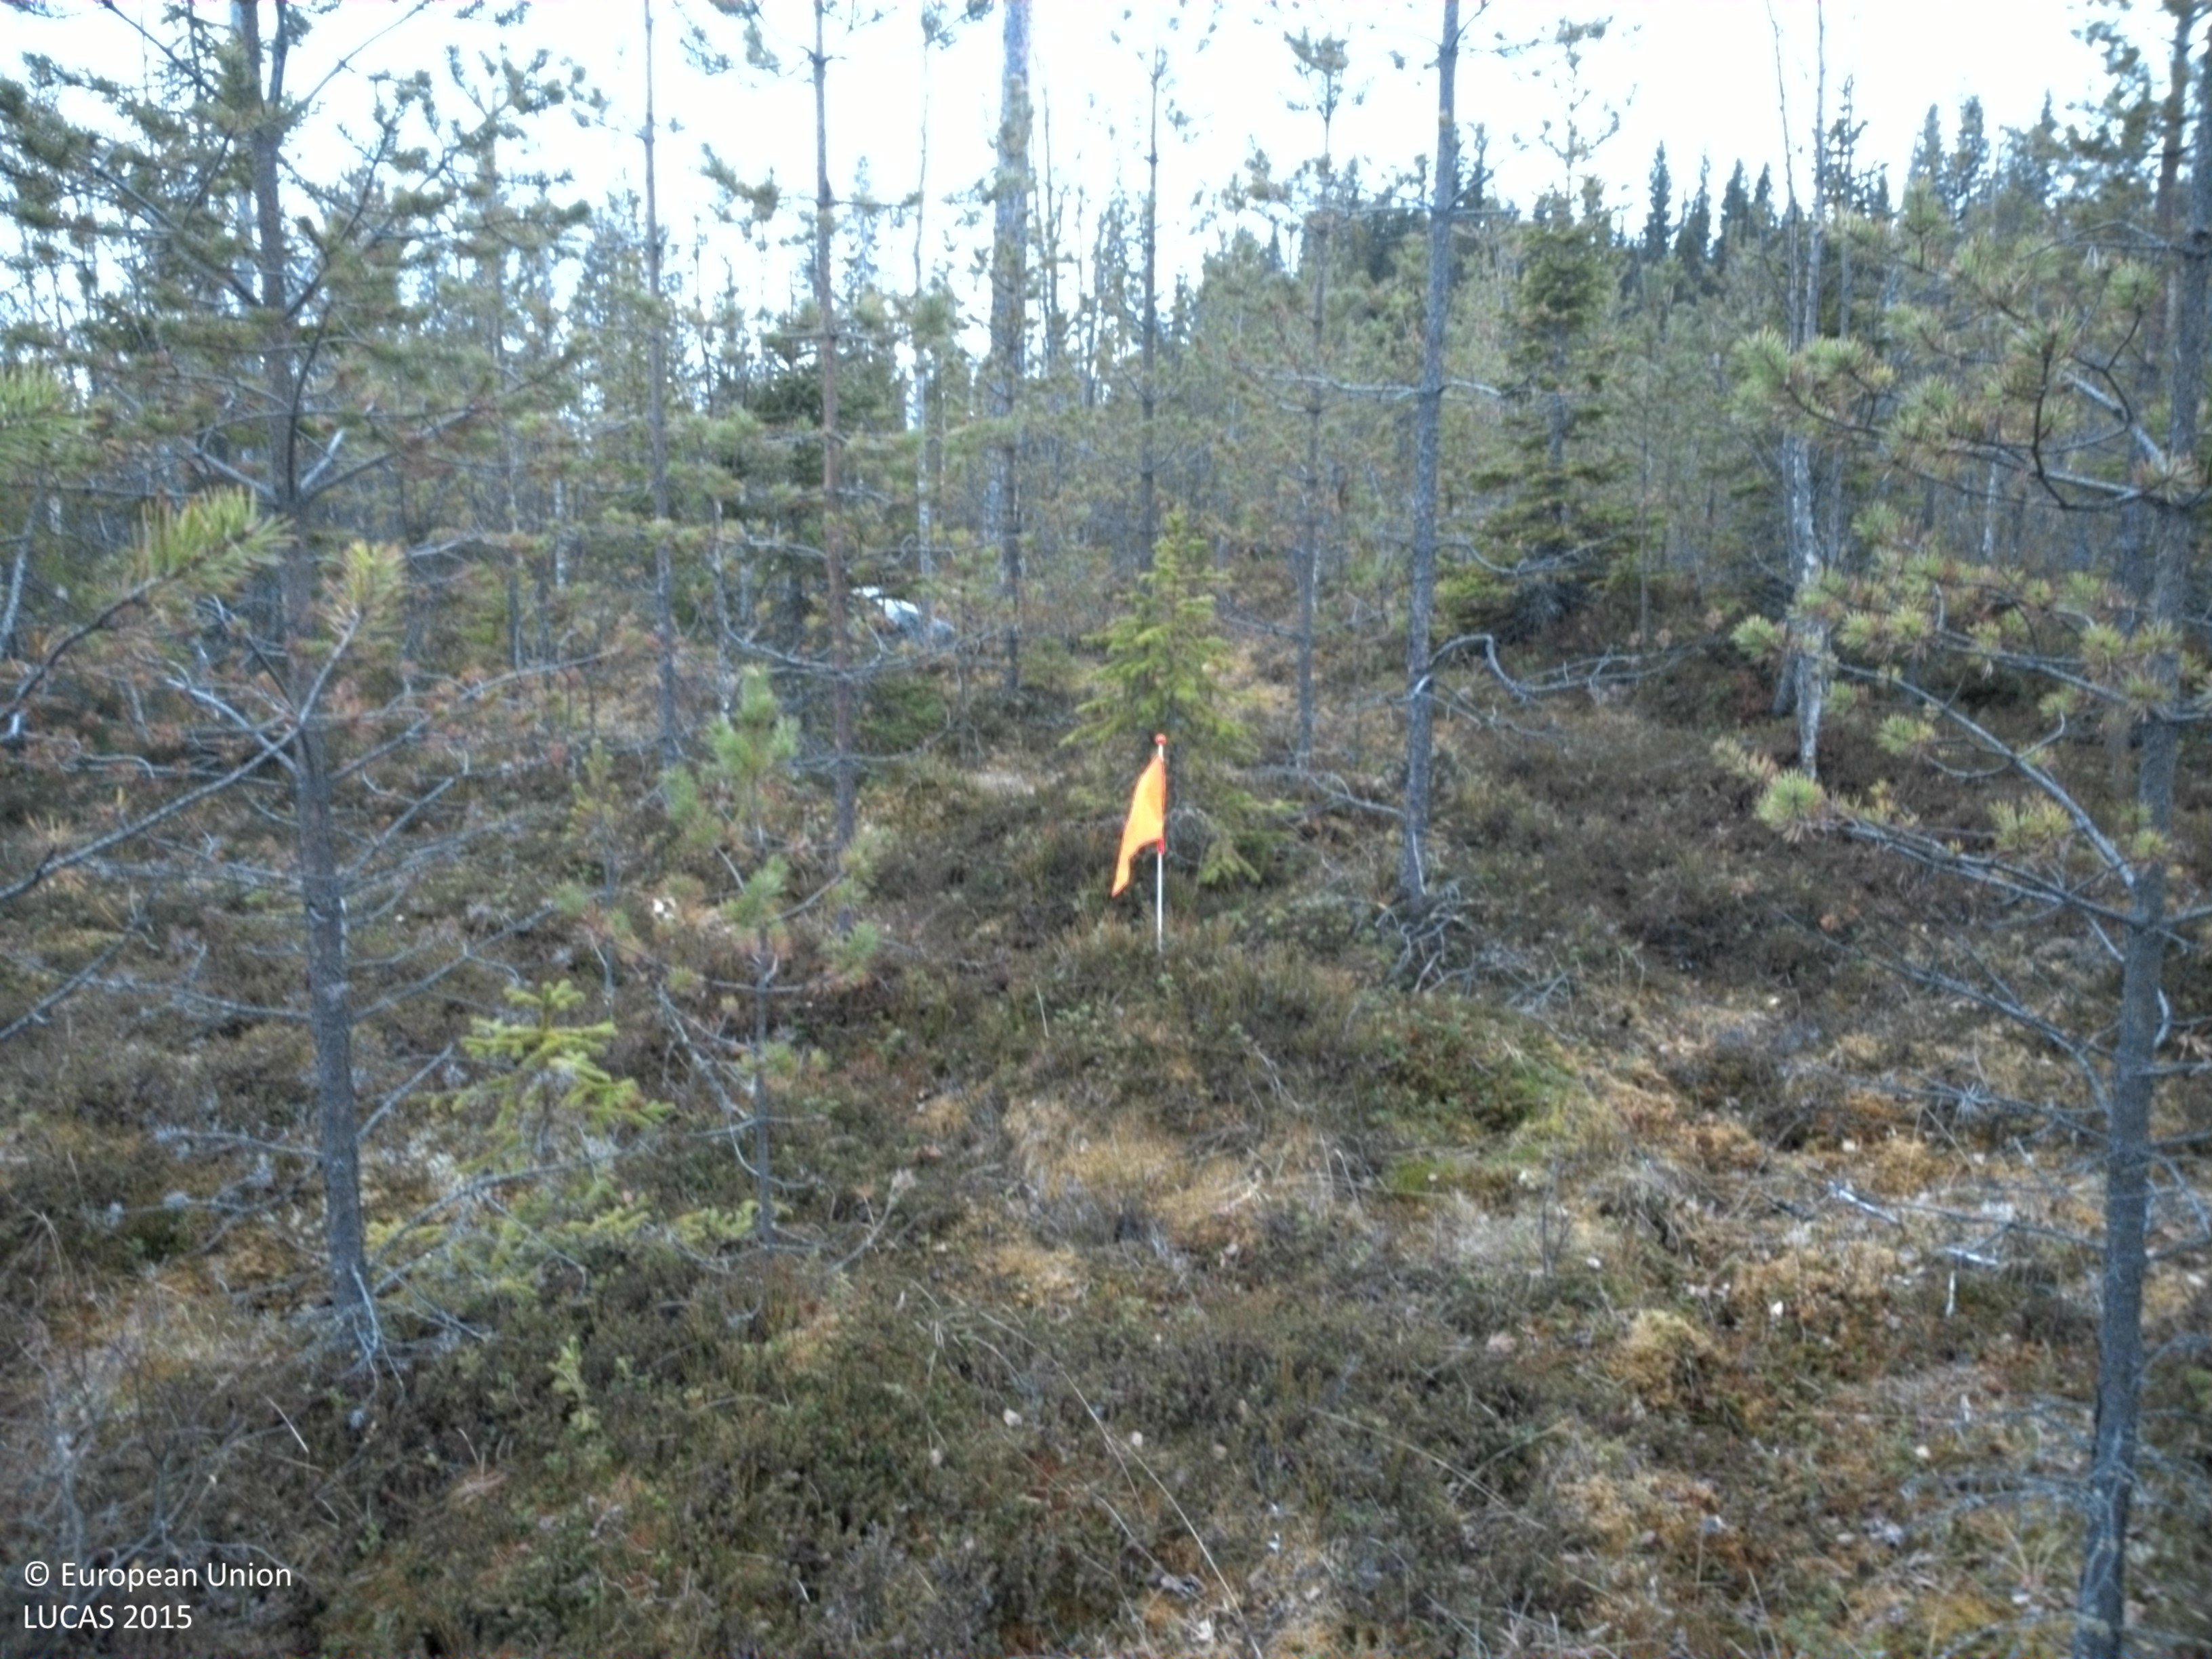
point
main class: Woodland
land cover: Pine dominated coniferous woodland
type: boreal forest
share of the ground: > 75 %
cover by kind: coniferous forest trees 85 %, shrubs 10 %, broadleaved forest trees 5 %
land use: Forestry
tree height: > 5 m
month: May
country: SE
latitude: 62.5830
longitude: 14.4393
